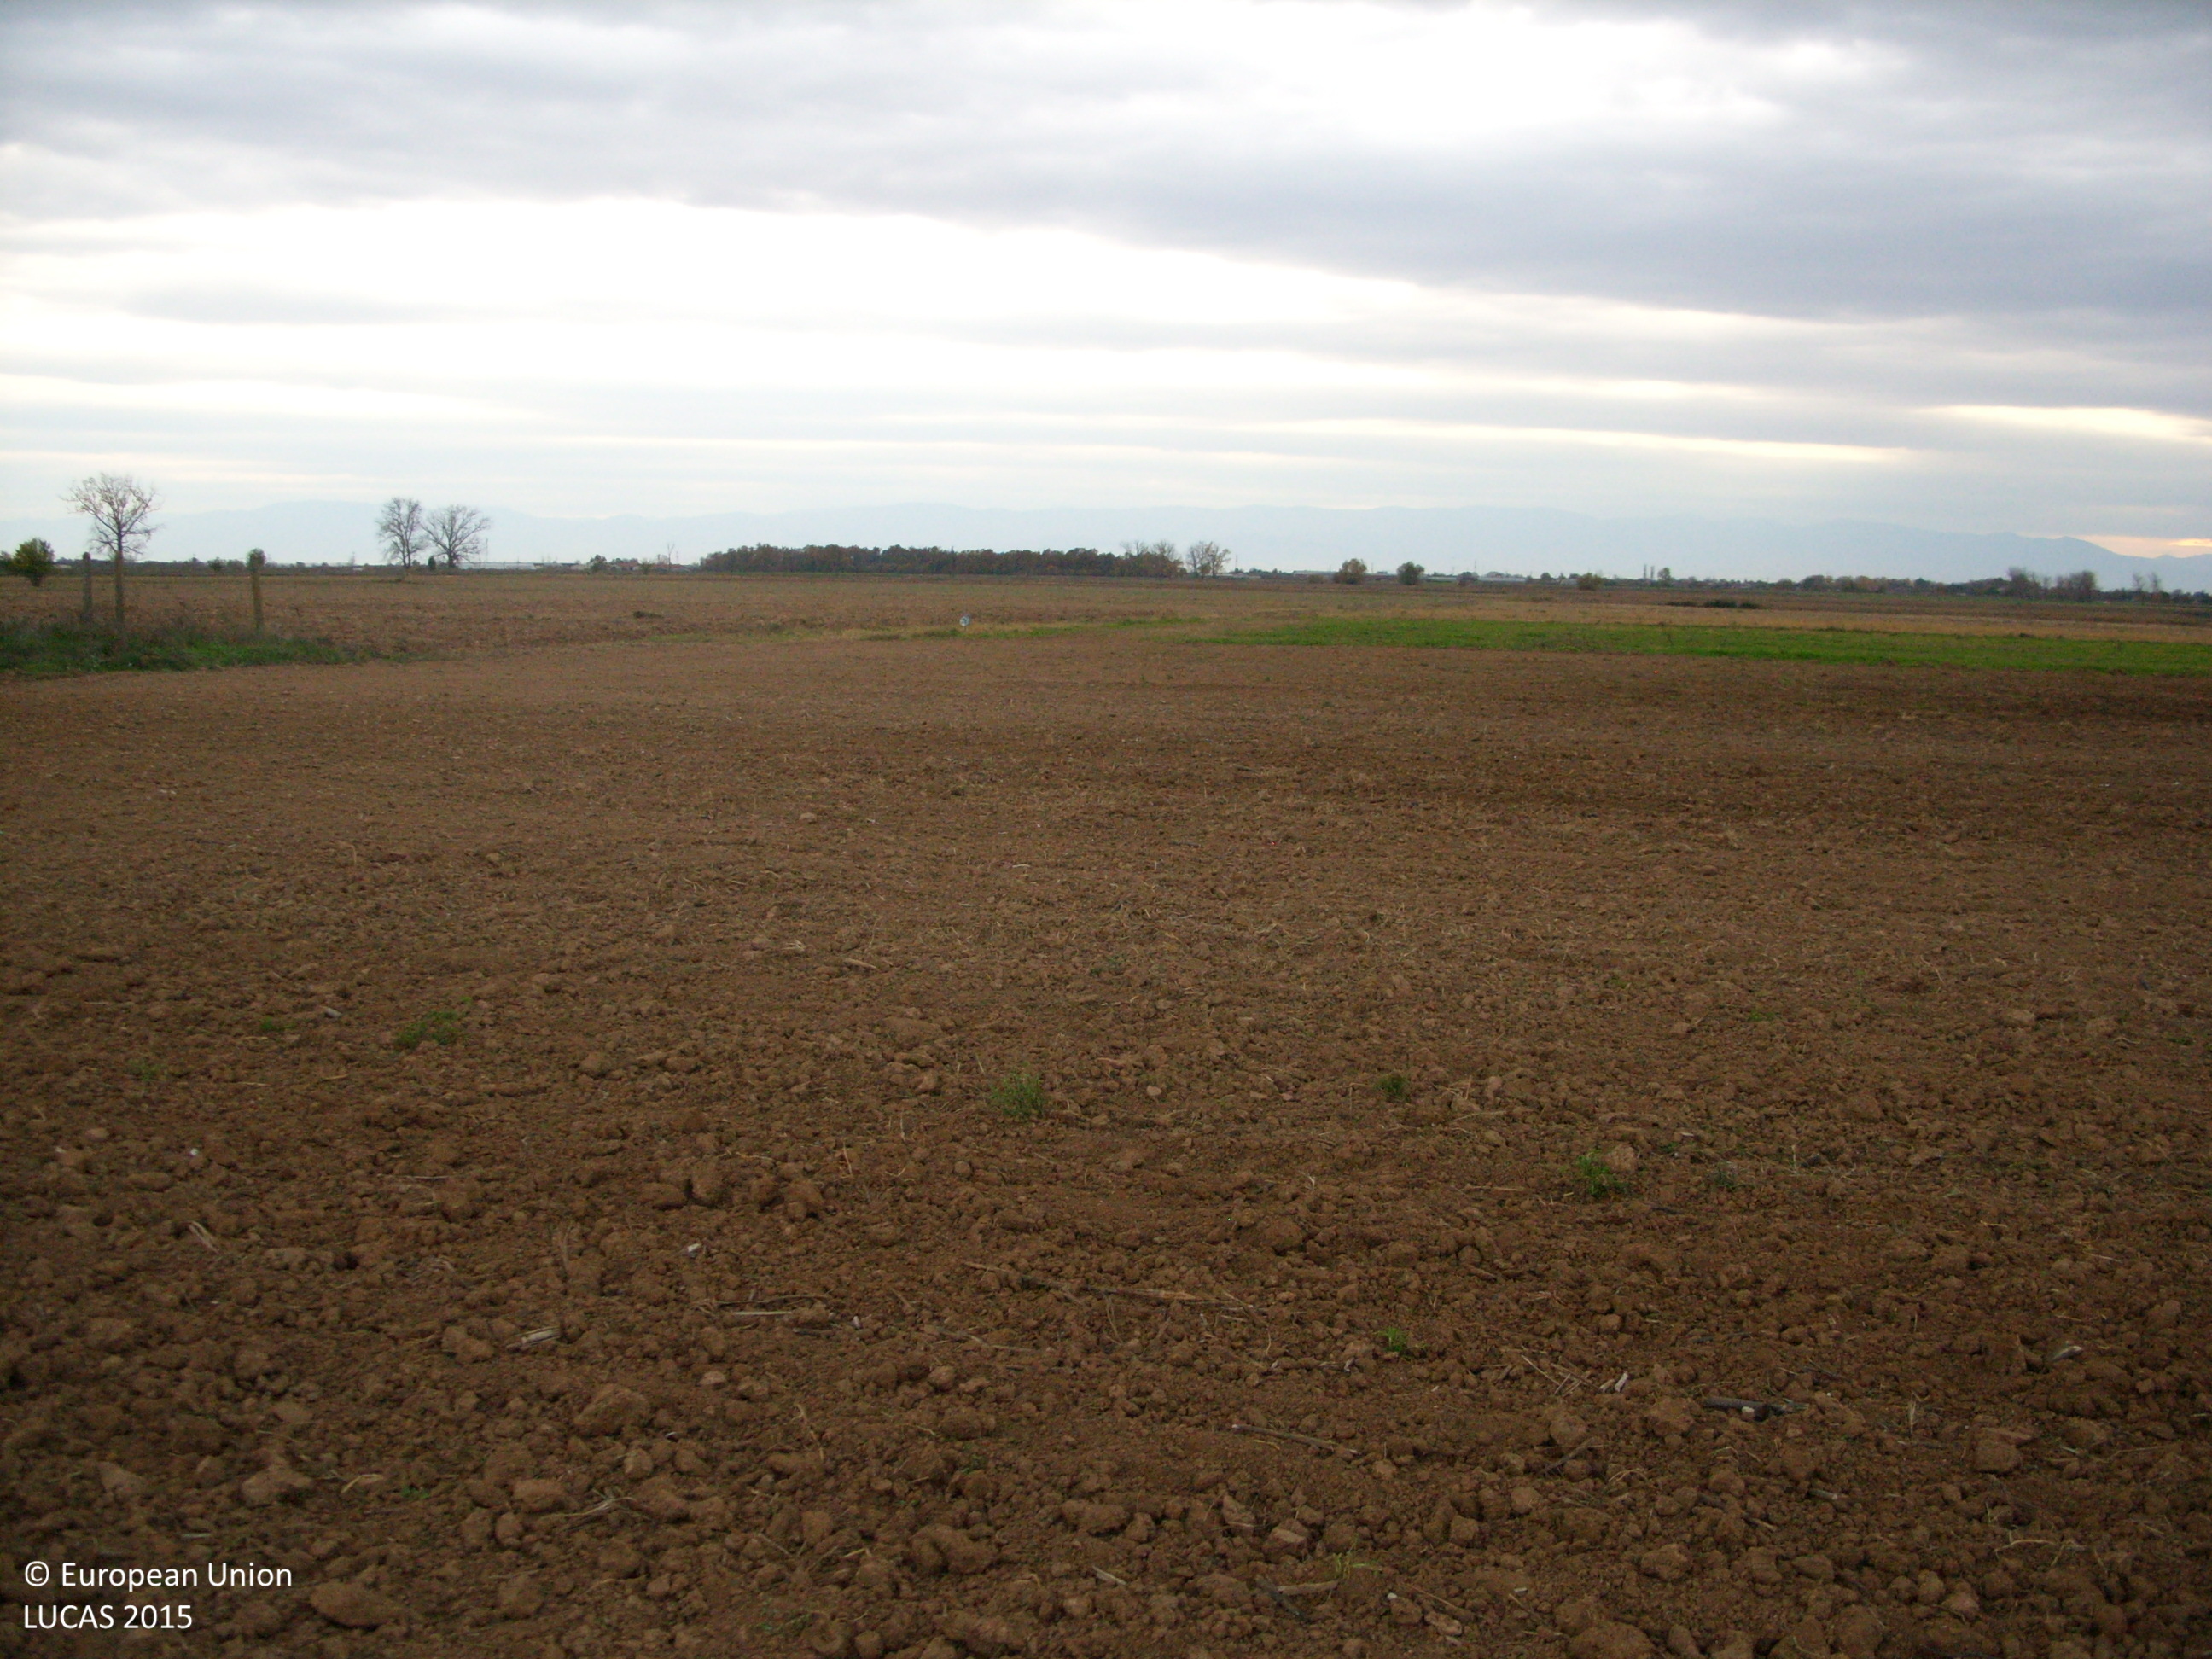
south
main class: Cropland
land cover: Rape and turnip rape
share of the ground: < 10 %
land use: Agriculture (excluding fallow land and kitchen gardens)
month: November
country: BG
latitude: 42.3616
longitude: 24.8320
